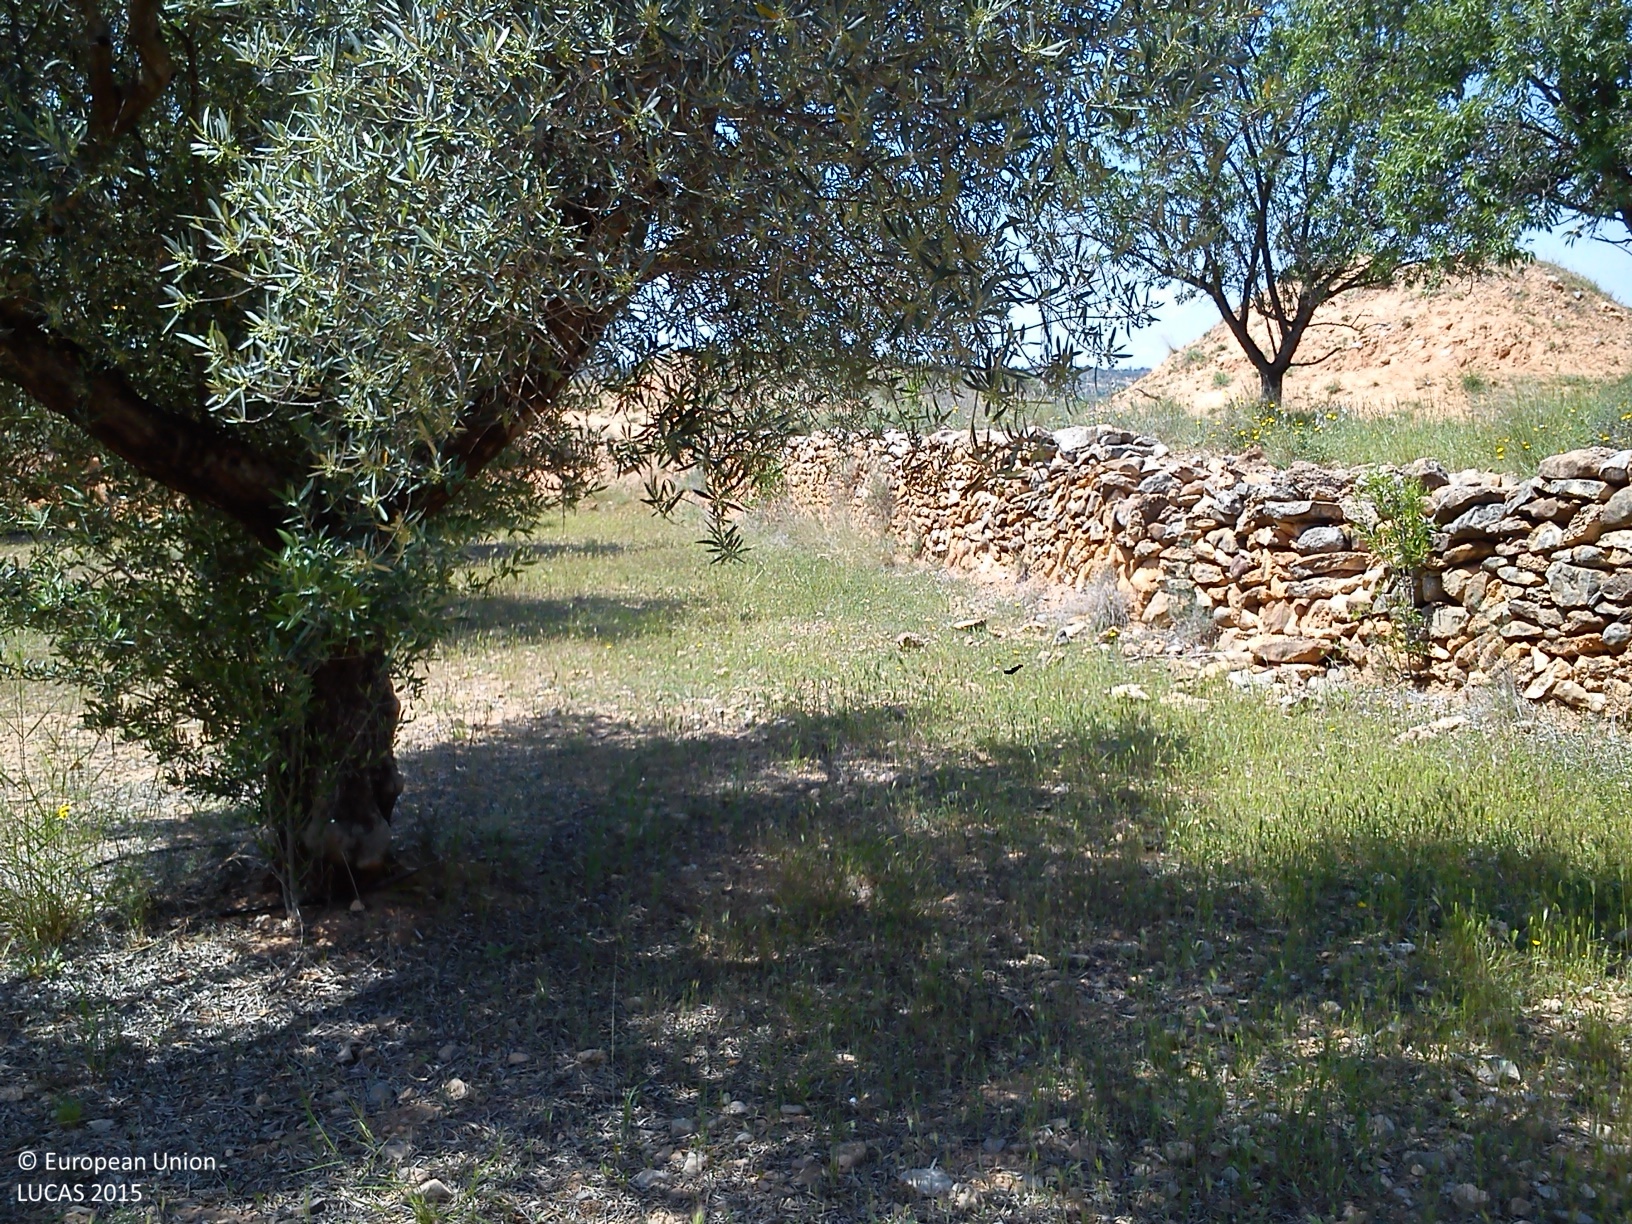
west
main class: Cropland
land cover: Olive groves
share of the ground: 25 - 50 %
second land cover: Spontaneously vegetated surfaces
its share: 25 - 50 %
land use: Agriculture (excluding fallow land and kitchen gardens)
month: April
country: ES
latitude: 39.6300
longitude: -0.6607
